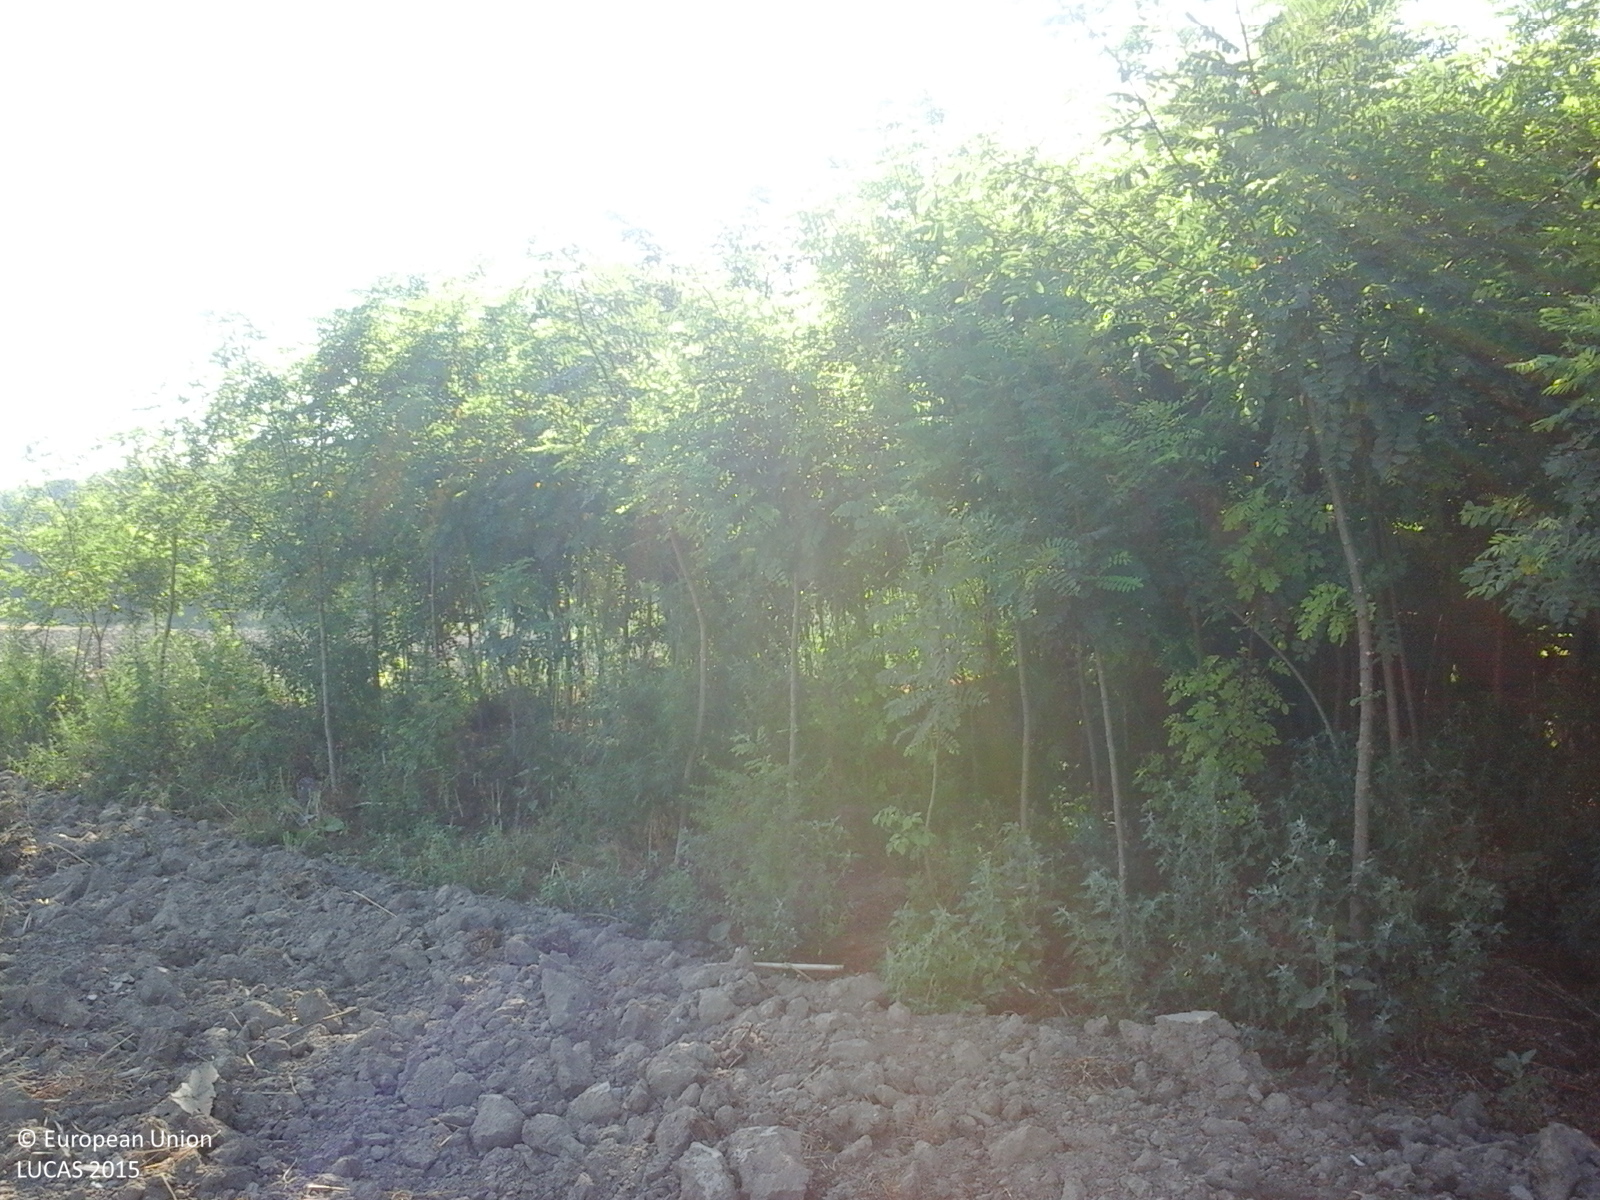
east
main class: Cropland
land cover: Common wheat
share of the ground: < 10 %
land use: Agriculture (excluding fallow land and kitchen gardens)
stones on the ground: < 10 %
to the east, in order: Common wheat; Broadleaved woodland; Common wheat; Spontaneously vegetated surfaces; Tracks; Spontaneously vegetated surfaces; Broadleaved woodland; Arable land (only in case pi)
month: July
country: RO
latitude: 44.2802
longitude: 27.9591
